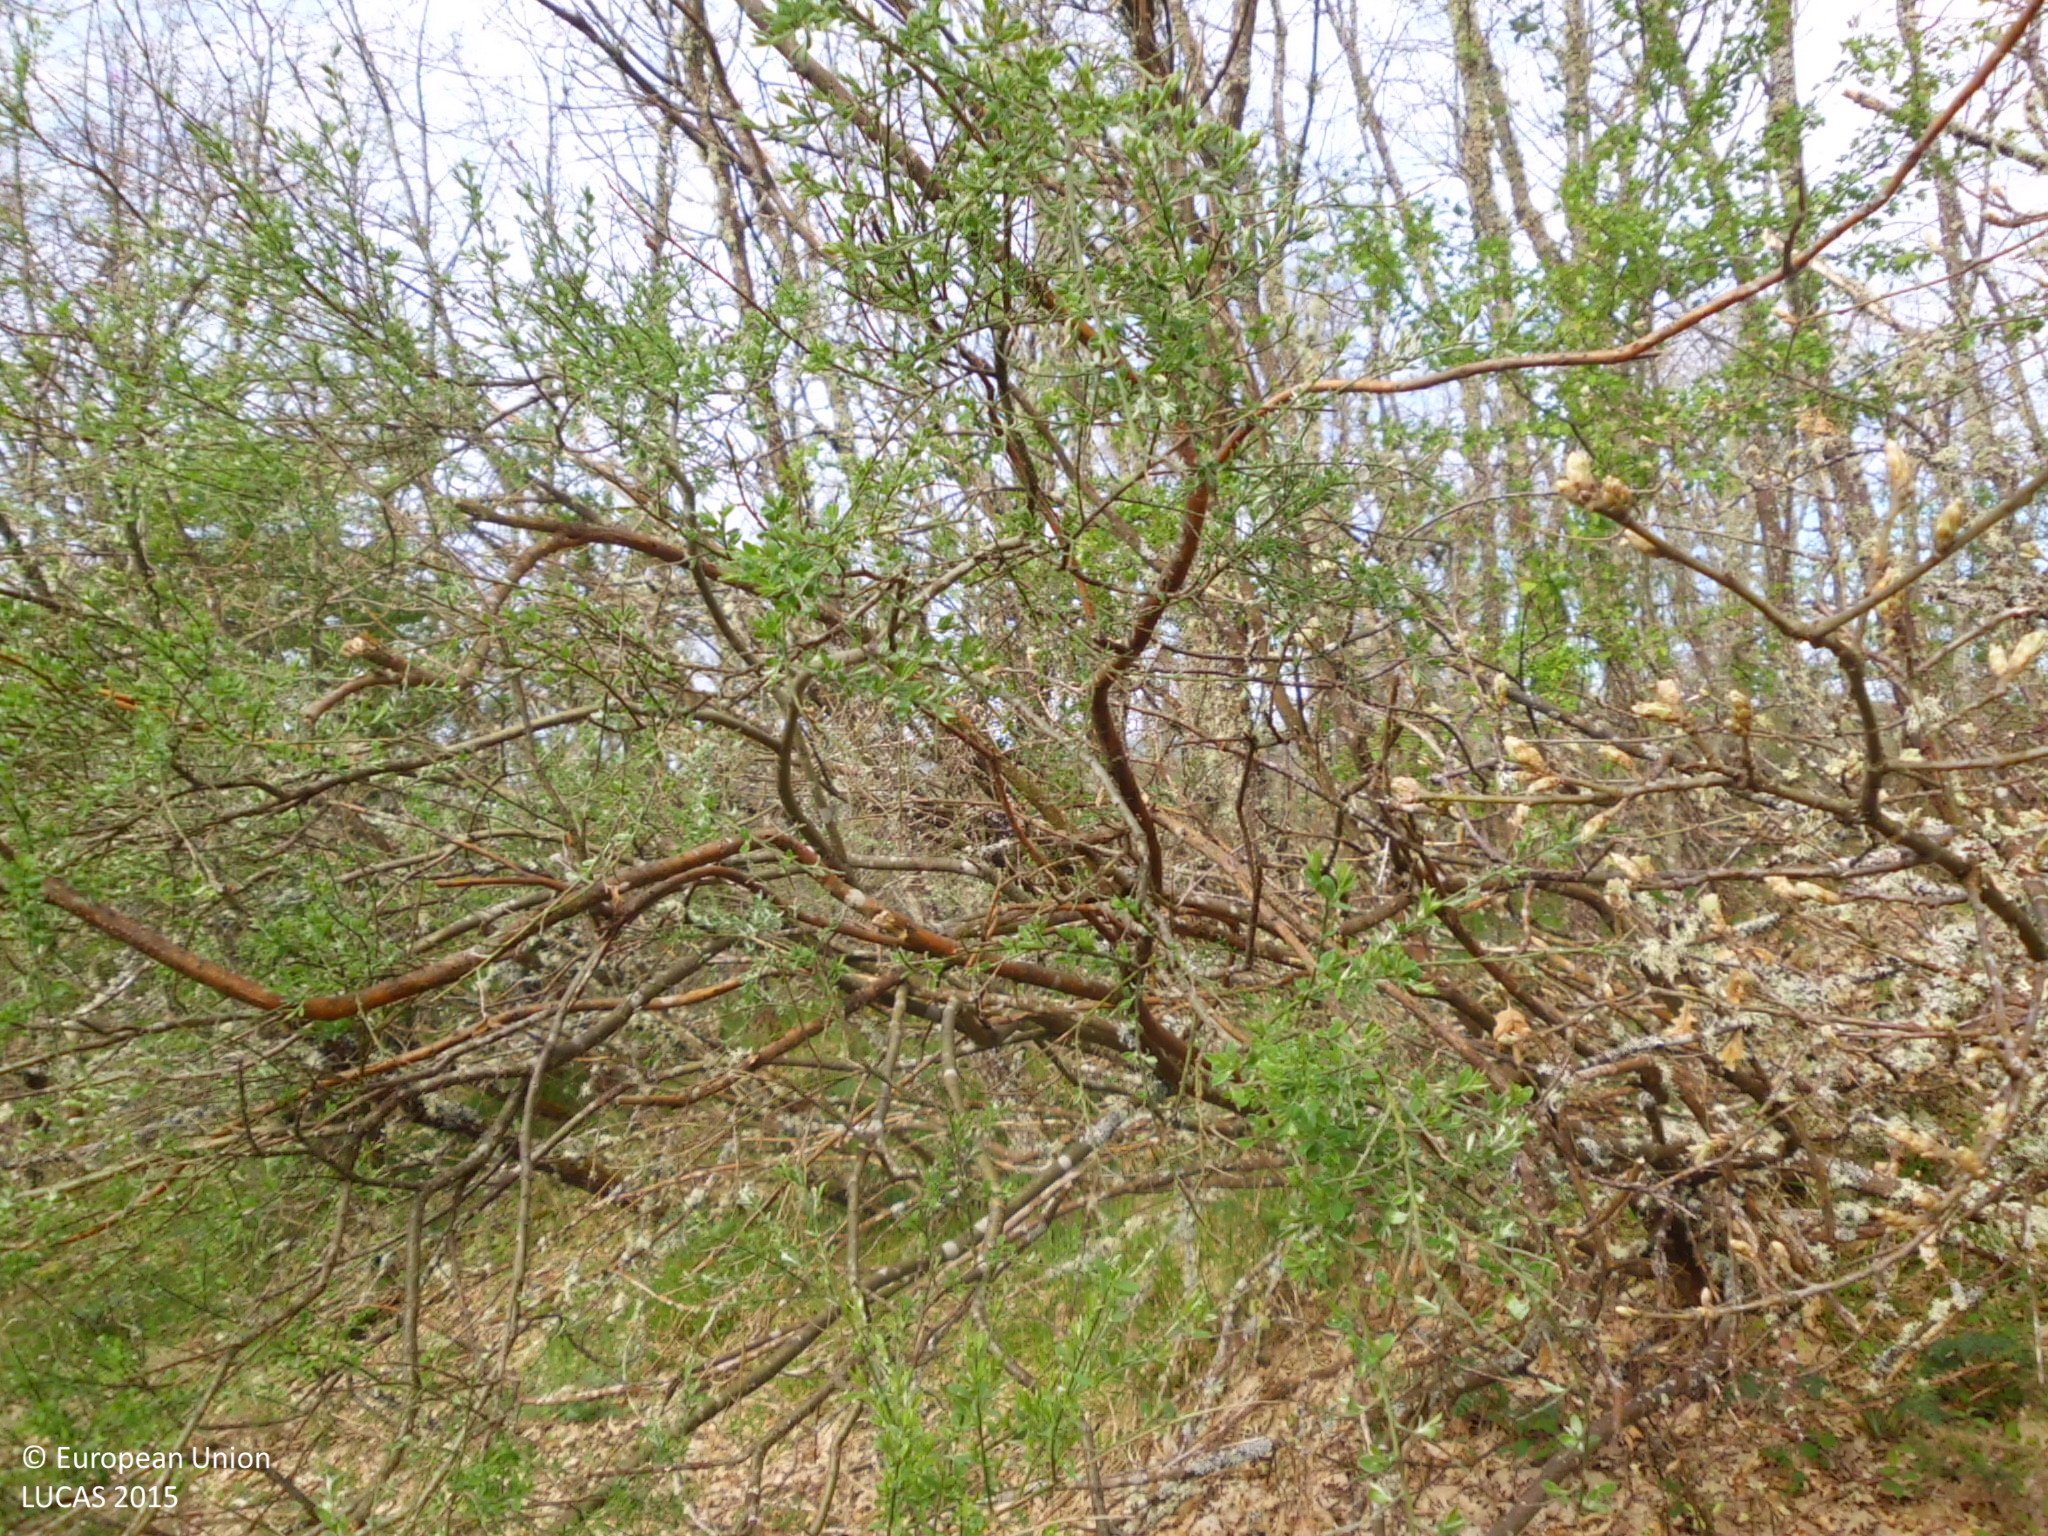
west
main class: Woodland
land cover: Broadleaved woodland
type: acidophilous oak and oak-birch forest
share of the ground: 50 - 75 %
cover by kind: broadleaved forest trees 70 %, herbaceous plants 20 %, shrubs 10 %
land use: Semi-natural and natural areas not in use
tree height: > 5 m
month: May
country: ES
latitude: 42.9194
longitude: -3.8760
